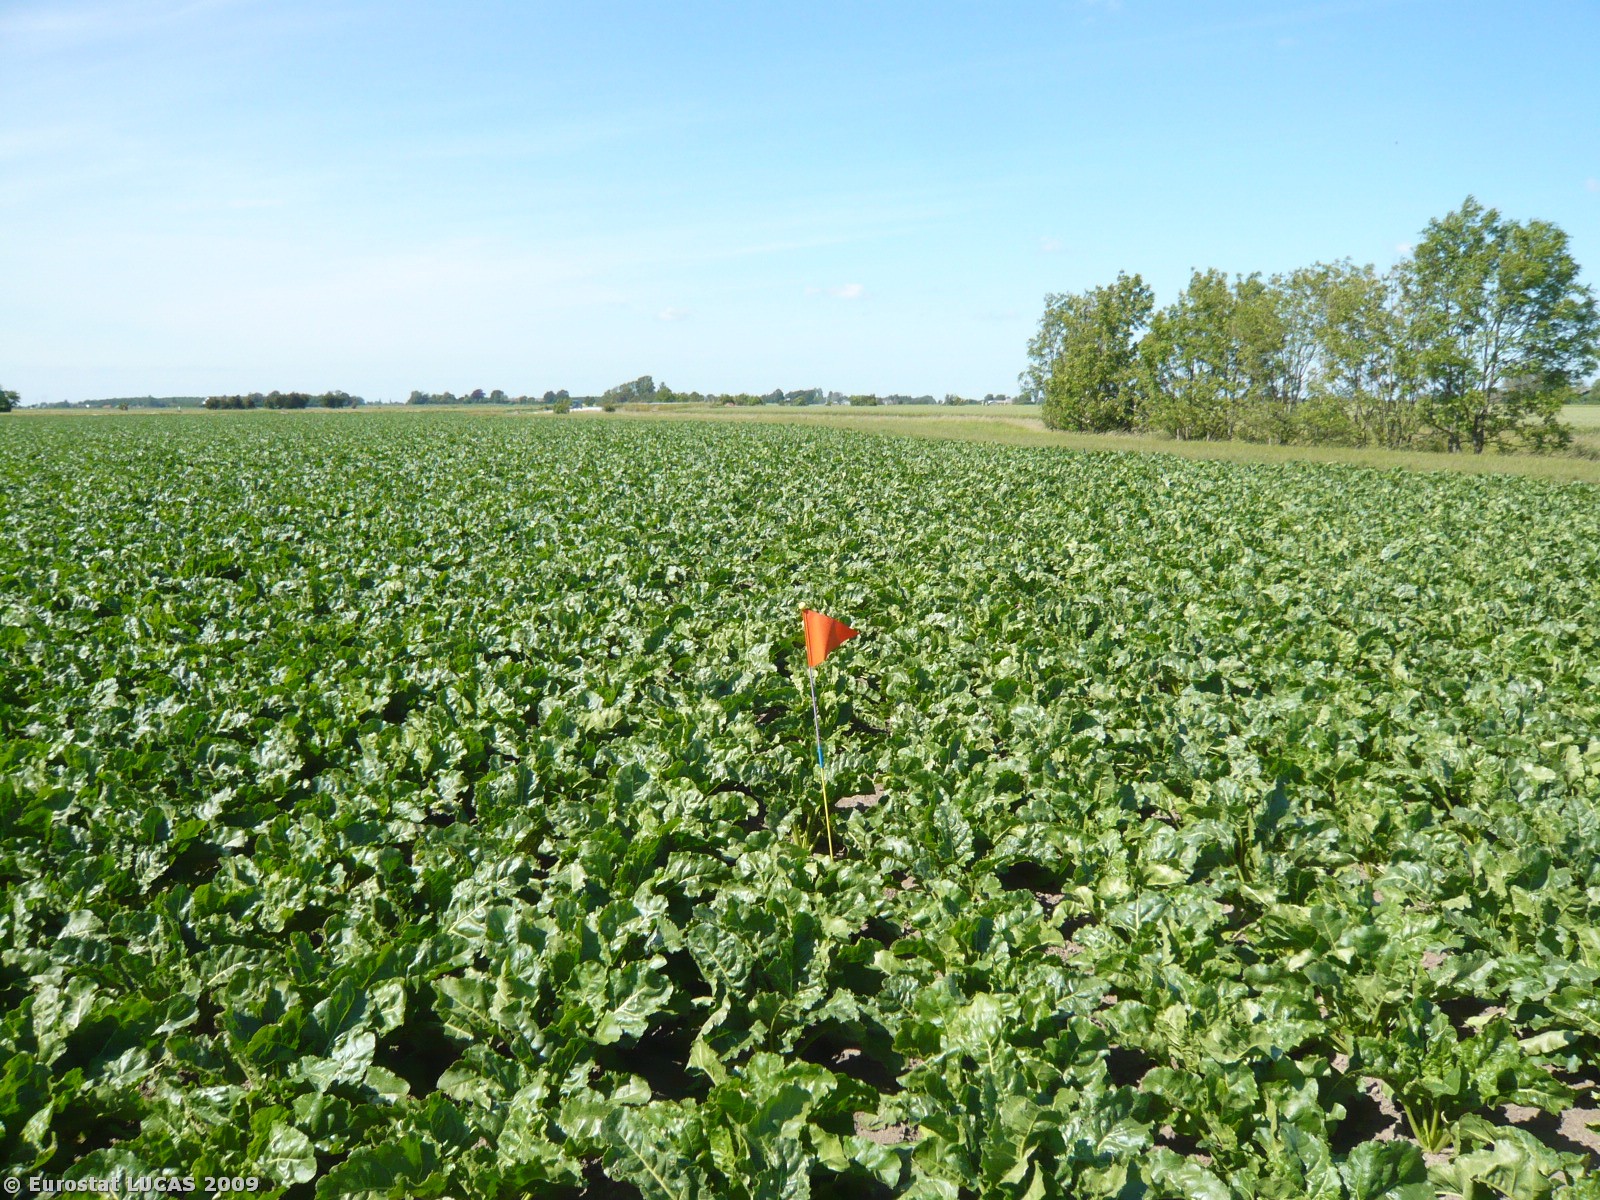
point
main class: Cropland
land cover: Sugar beet
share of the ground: > 75 %
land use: Agriculture (excluding fallow land and kitchen gardens)
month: June
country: DK
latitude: 54.7980
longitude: 11.1969
